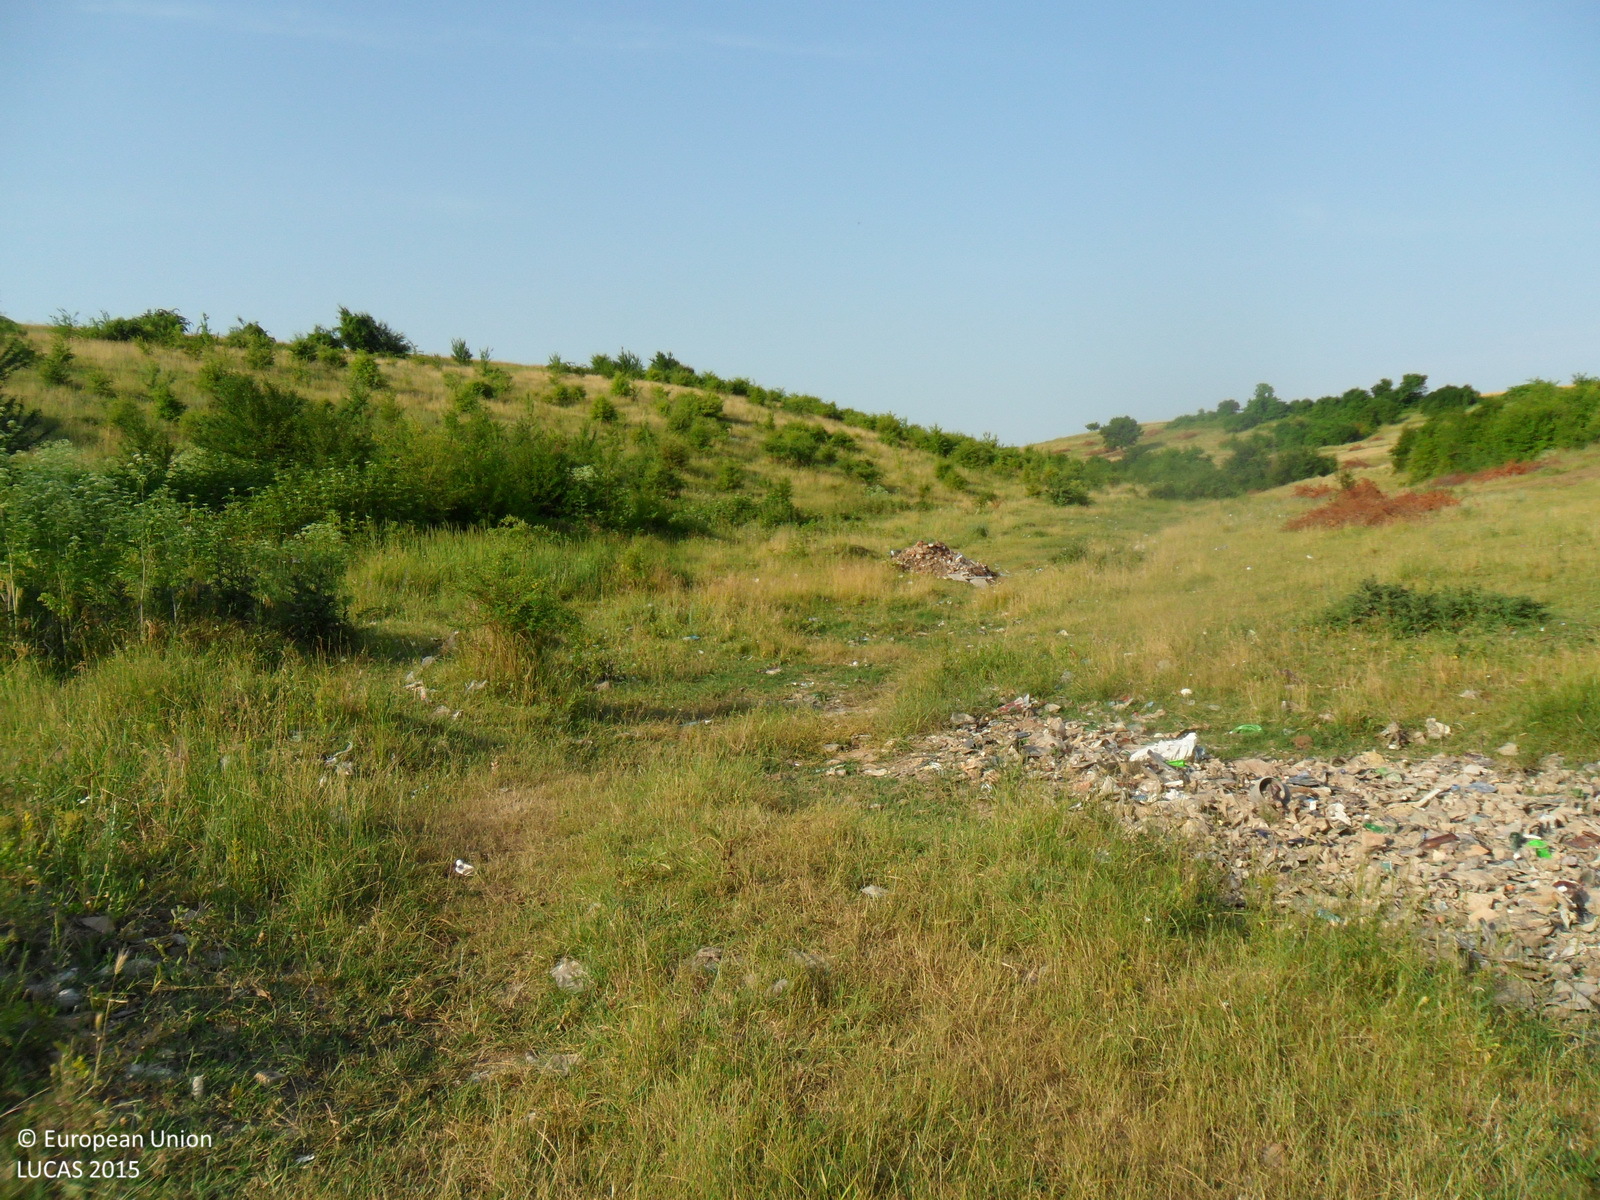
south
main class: Grassland
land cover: Grassland with sparse tree/shrub cover
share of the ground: > 75 %
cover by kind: herbaceous plants 90 %, broadleaved forest trees 5 %, shrubs 5 %
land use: Agriculture (excluding fallow land and kitchen gardens)
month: June
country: BG
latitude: 43.6957
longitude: 26.8538
